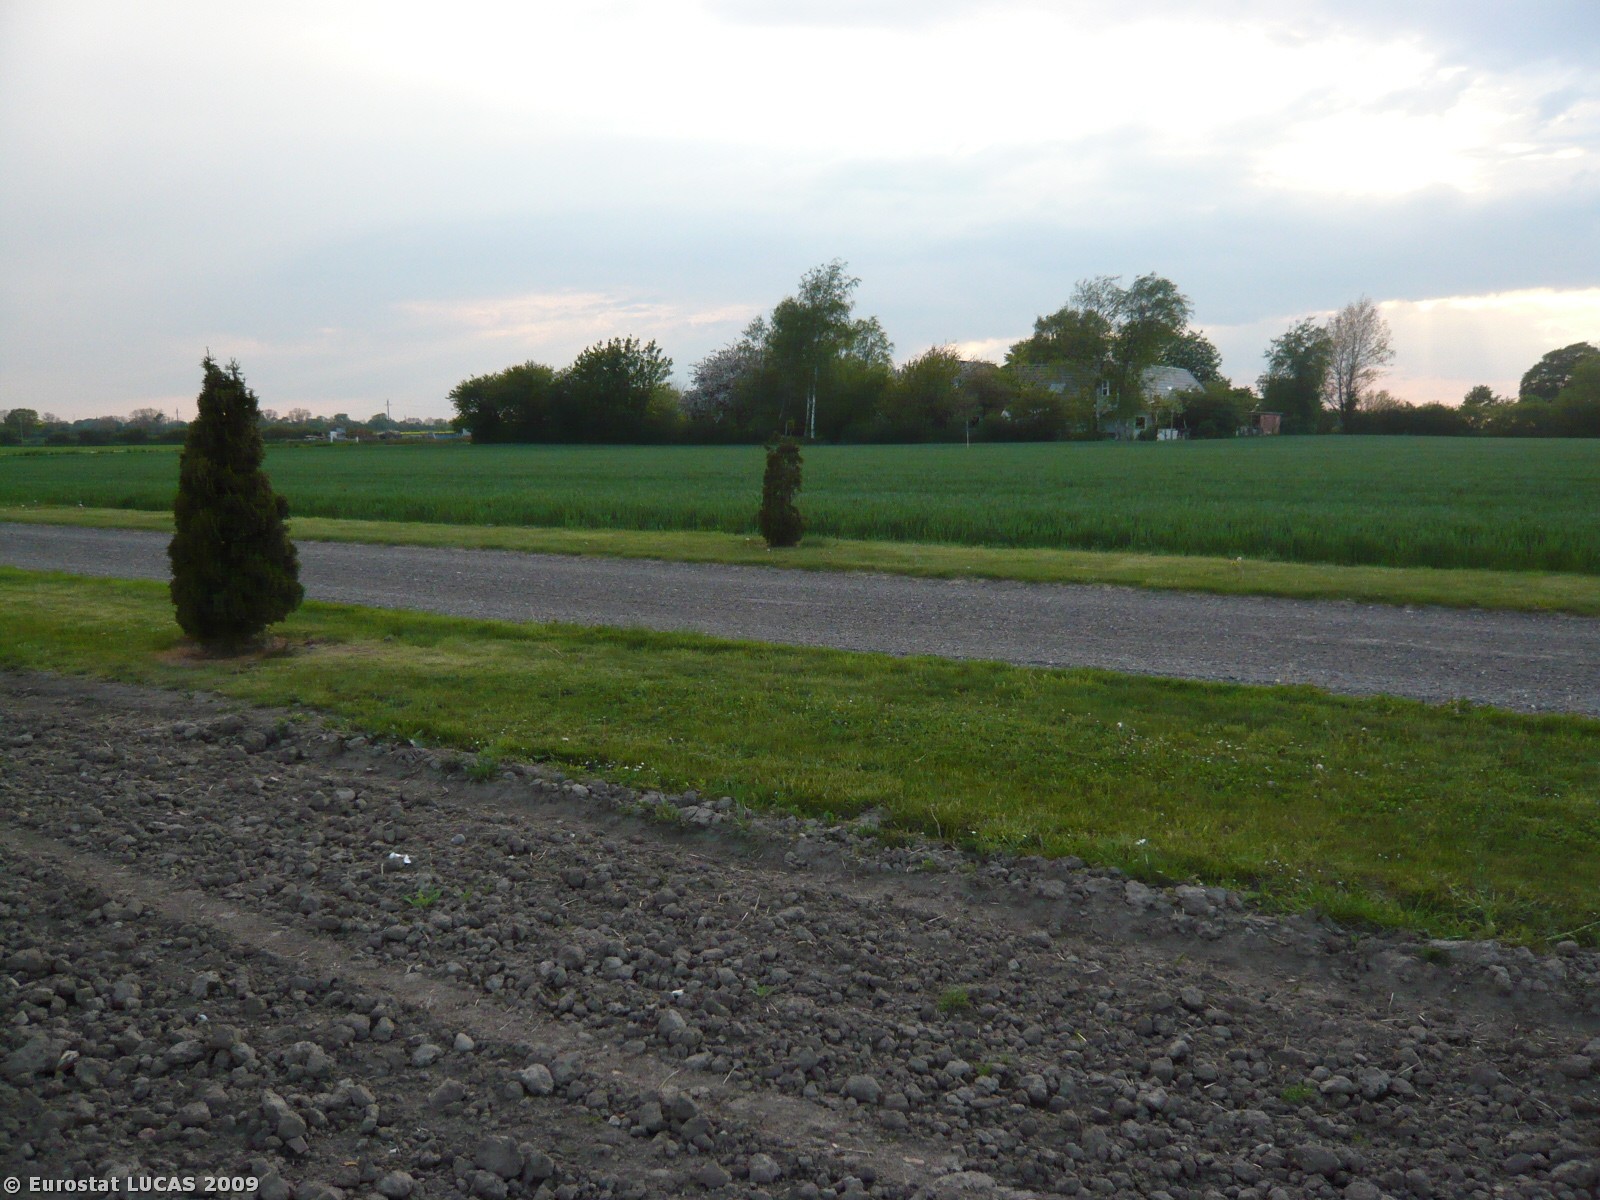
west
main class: Cropland
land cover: Other root crops
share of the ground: < 10 %
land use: Agriculture (excluding fallow land and kitchen gardens)
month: May
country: DK
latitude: 55.3223
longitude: 12.2835
